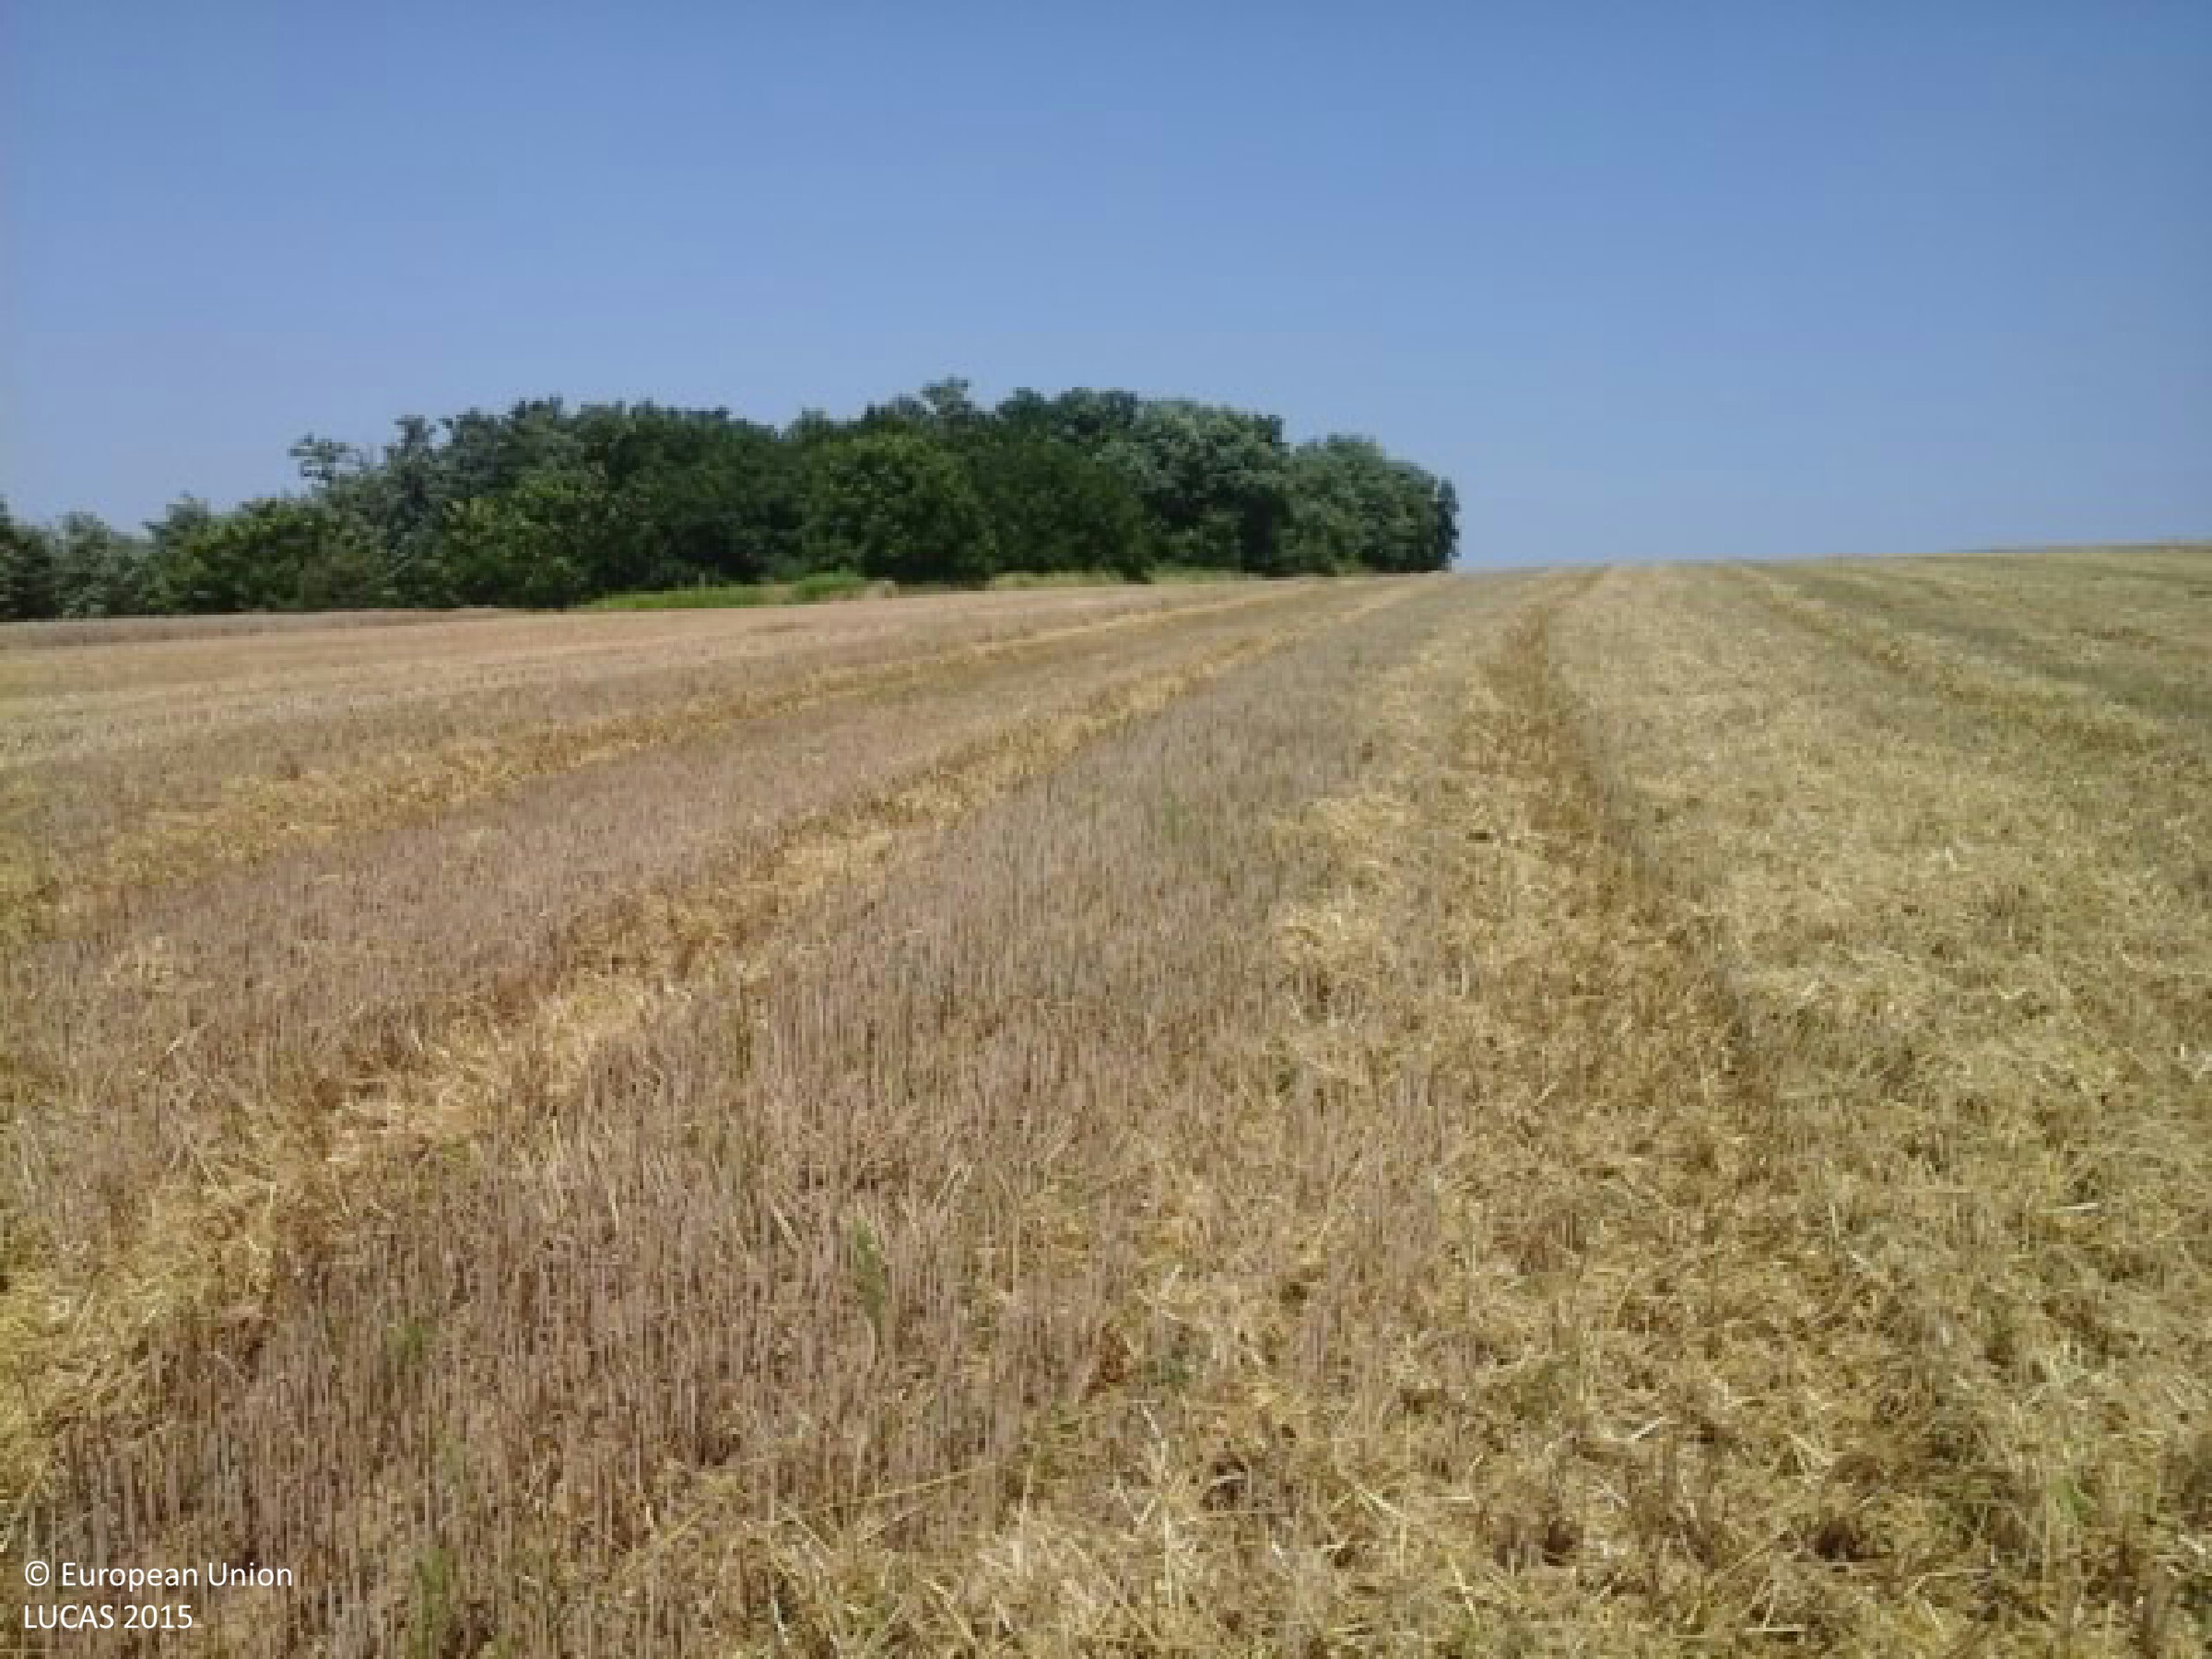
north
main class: Cropland
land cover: Common wheat
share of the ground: > 75 %
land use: Agriculture (excluding fallow land and kitchen gardens)
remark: Harvested field
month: July
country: HU
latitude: 46.2829
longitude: 17.0238
